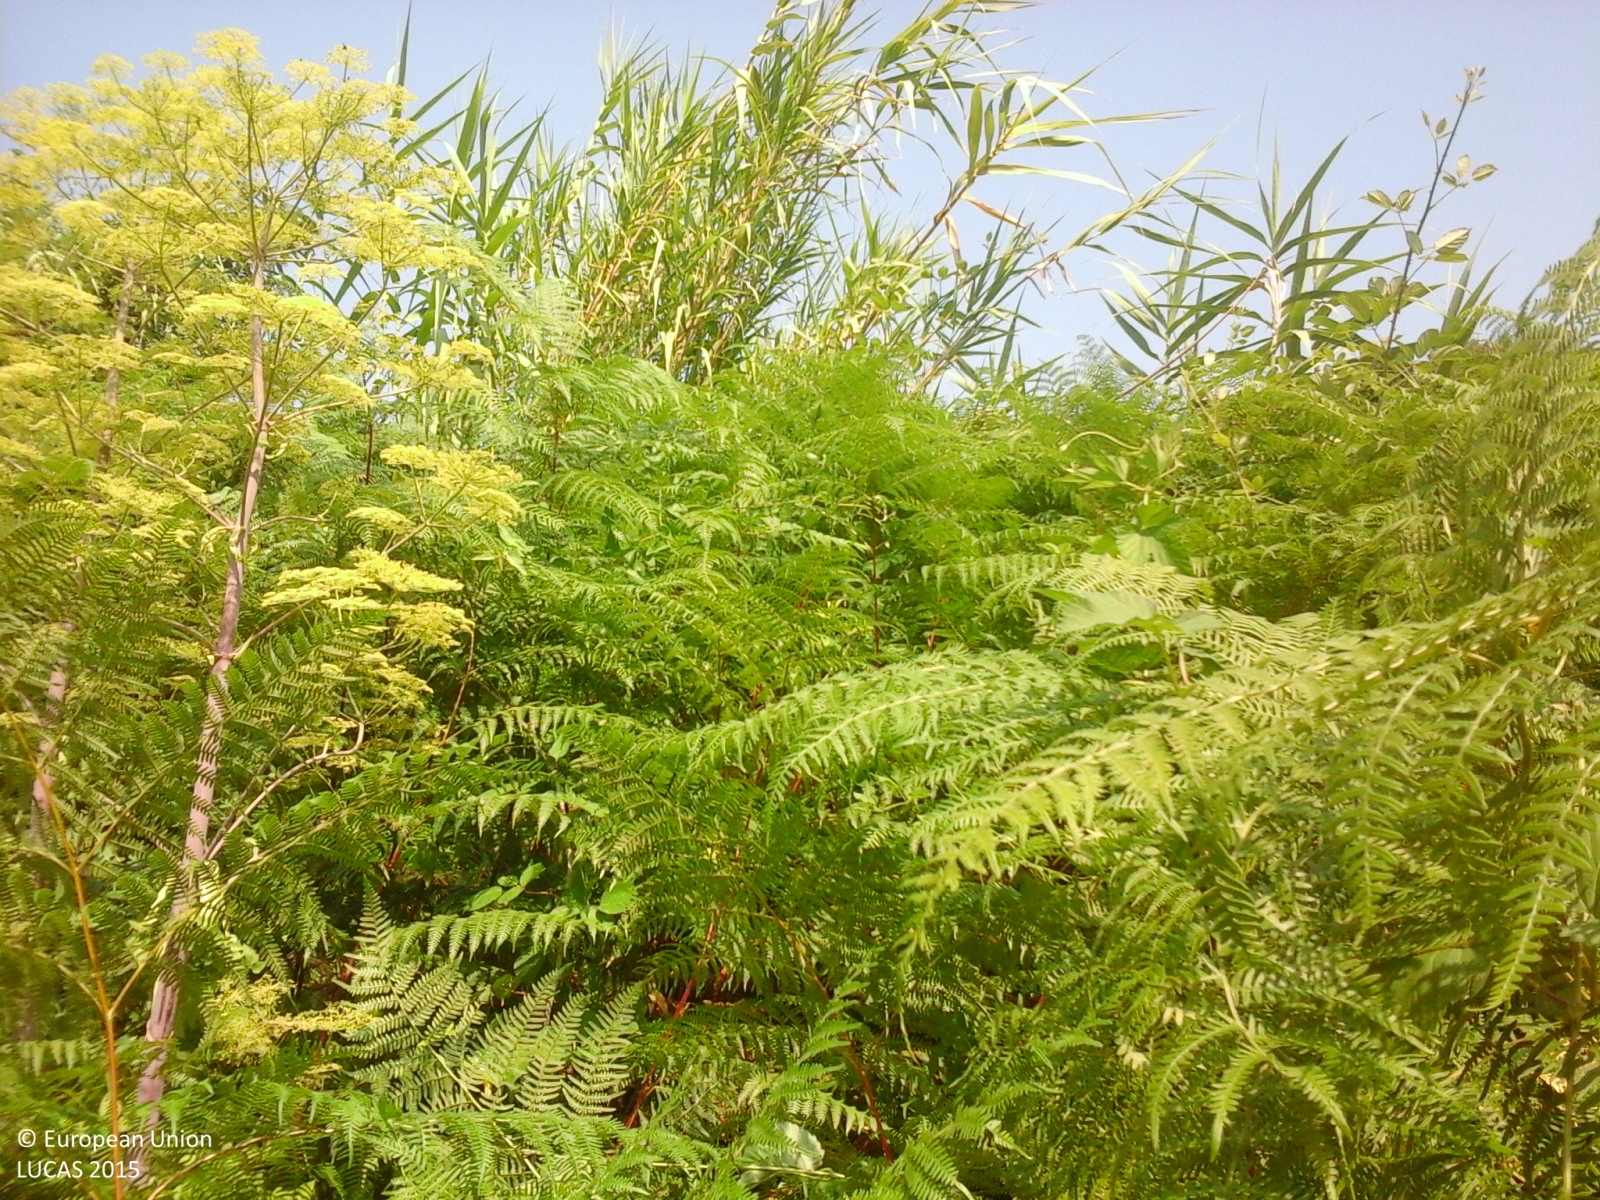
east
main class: Shrubland
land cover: Shrubland without tree cover
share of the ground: > 75 %
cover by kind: shrubs 100 %
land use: Semi-natural and natural areas not in use
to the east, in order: Shrubland without tree cover; Shrubland with sparse tree cover; Broadleaved woodland; Electric lines; Grass margins; Paved roads, cycling and walking lanes; Grass margins; Fences; Broadleaved woodland; Grassland with sparse tree/shrub cover; Broadleaved woodland
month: July
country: IT
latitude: 42.9564
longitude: 13.4594
